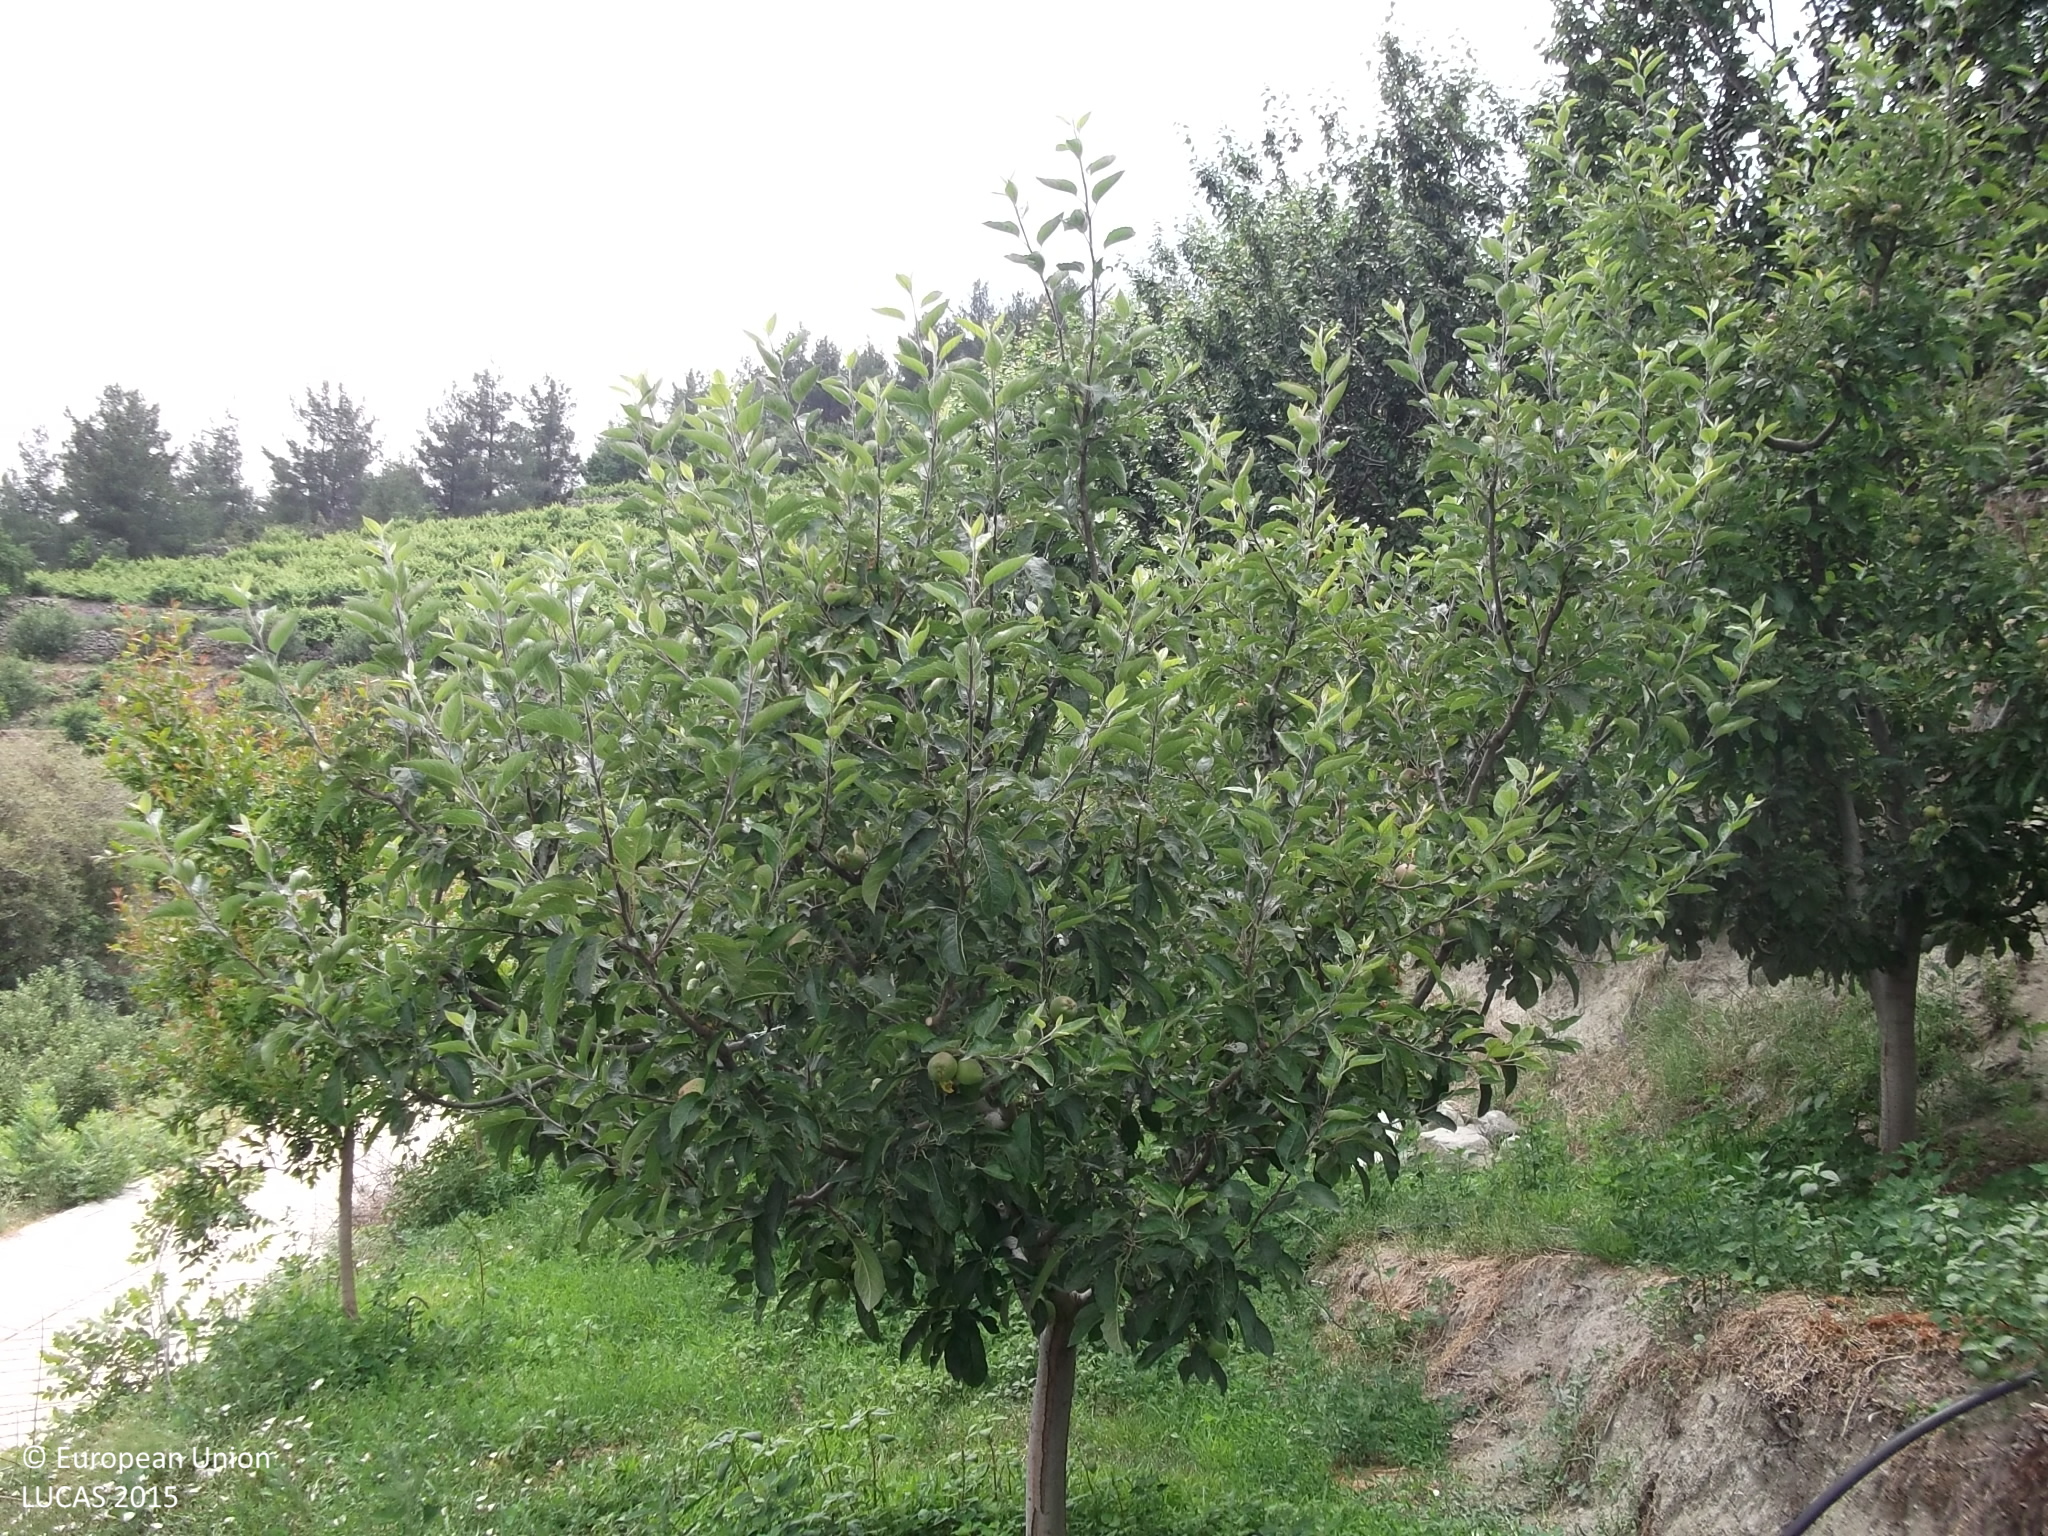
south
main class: Cropland
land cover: Apple fruit
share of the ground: 50 - 75 %
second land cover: Grassland without tree/shrub cover
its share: > 75 %
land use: Agriculture (excluding fallow land and kitchen gardens)
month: June
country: CY
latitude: 34.9144
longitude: 32.9690
